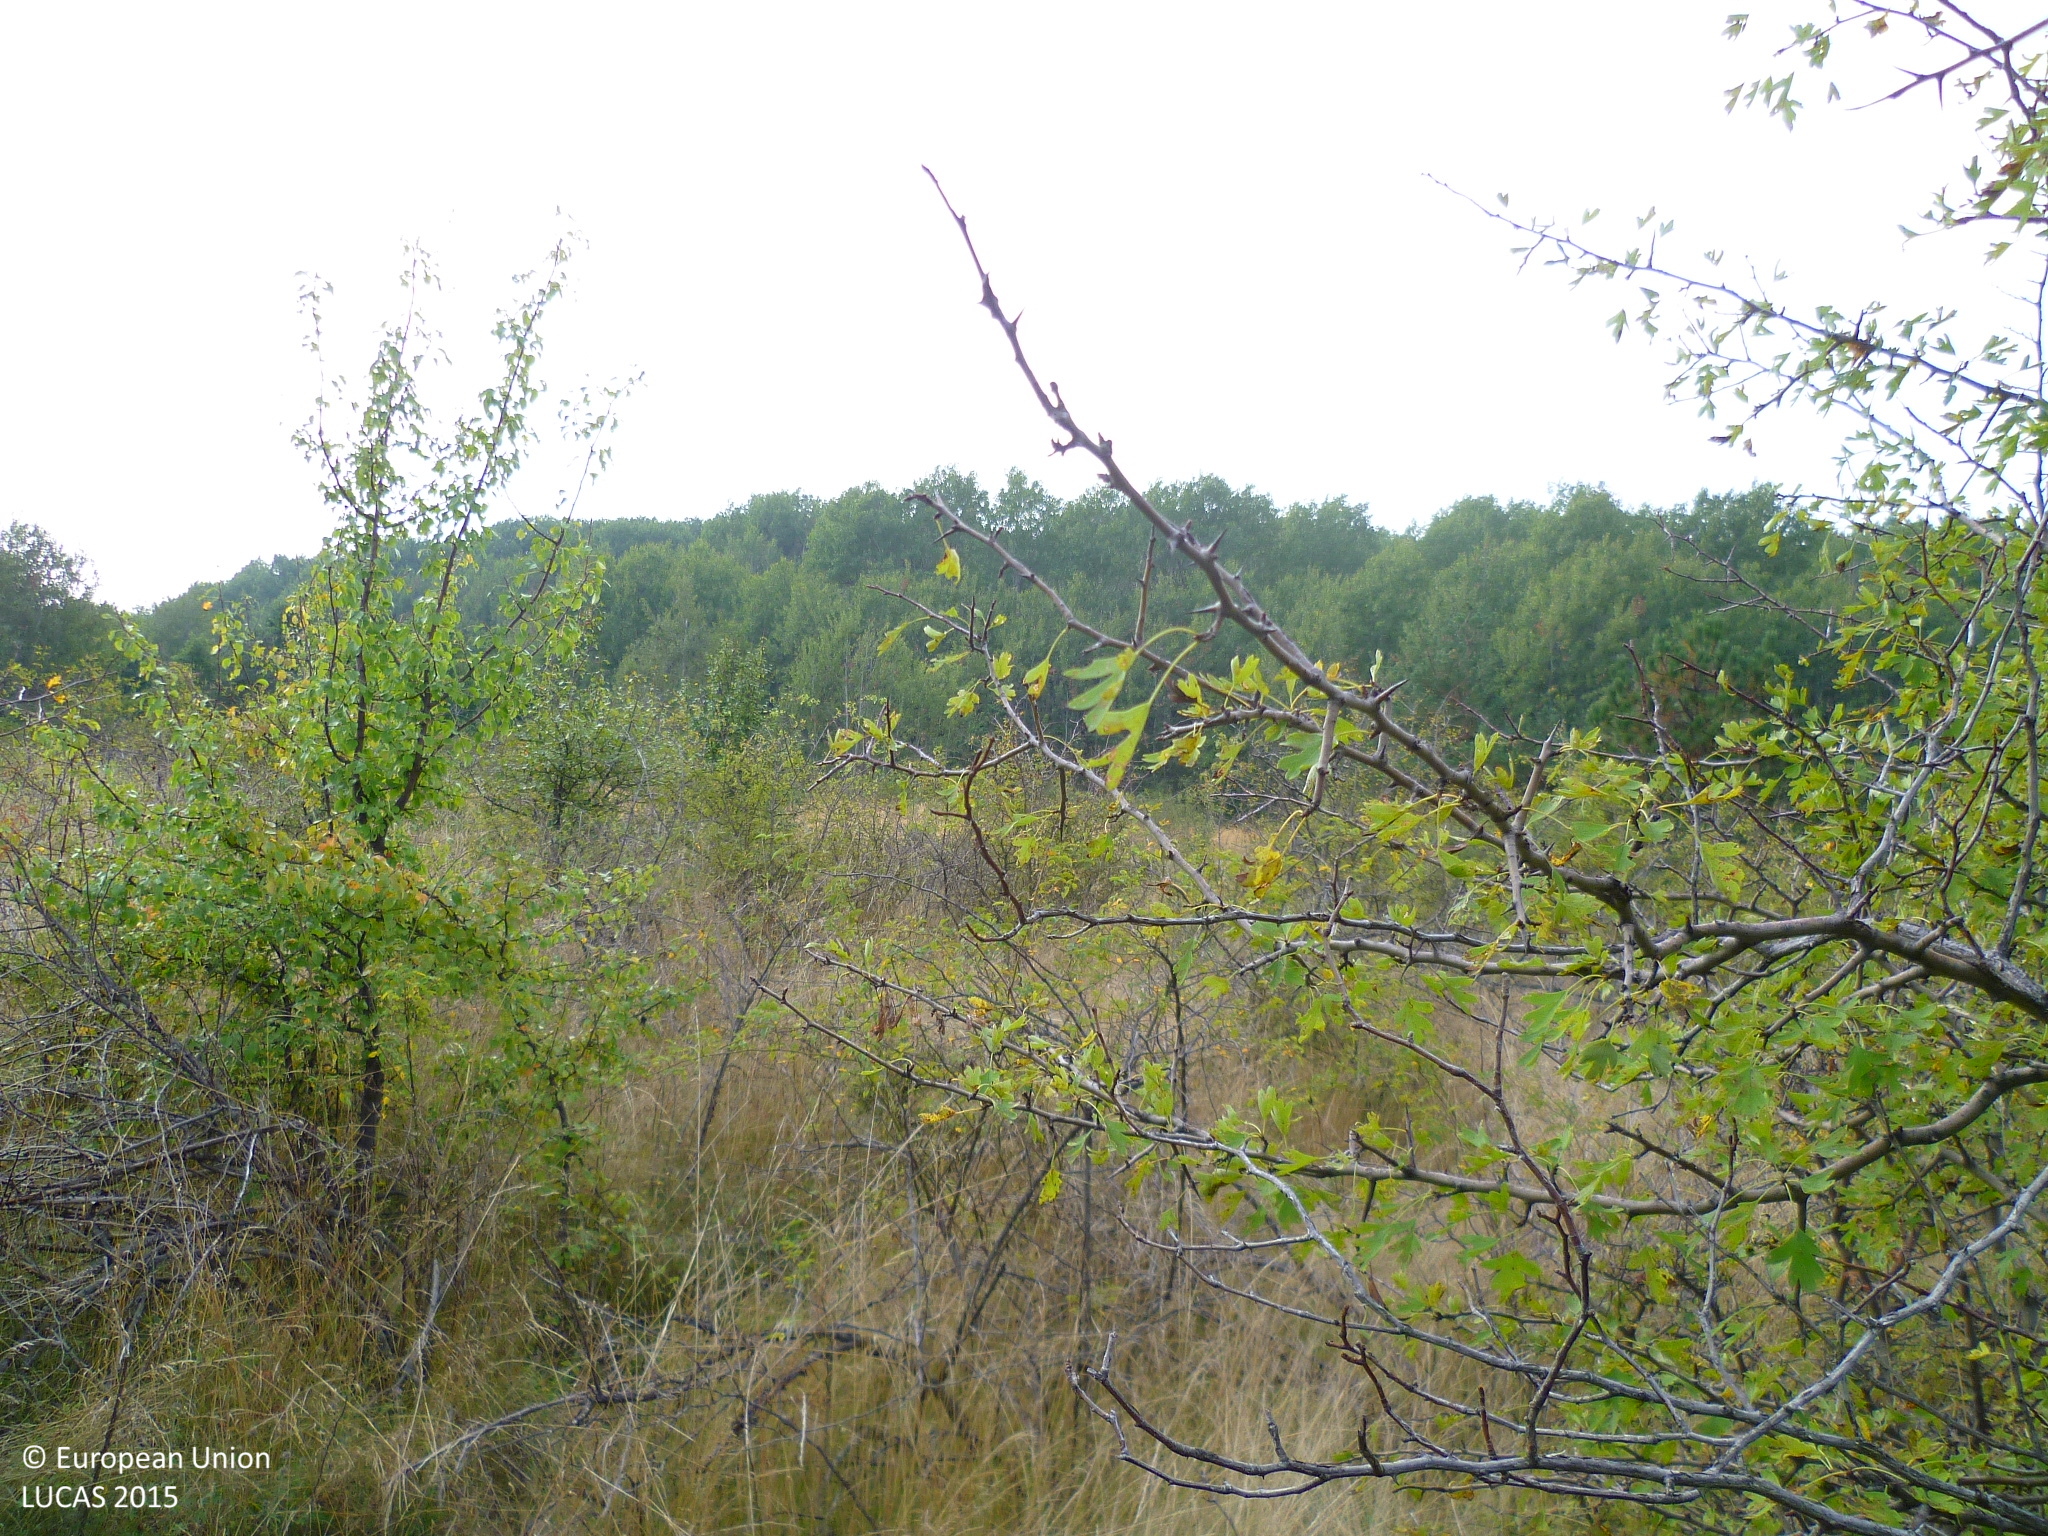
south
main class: Shrubland
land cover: Shrubland with sparse tree cover
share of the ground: 50 - 75 %
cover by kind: shrubs 65 %, herbaceous plants 30 %, broadleaved forest trees 5 %
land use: Semi-natural and natural areas not in use
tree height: < 5 m
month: September
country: BG
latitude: 42.7951
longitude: 23.0275
